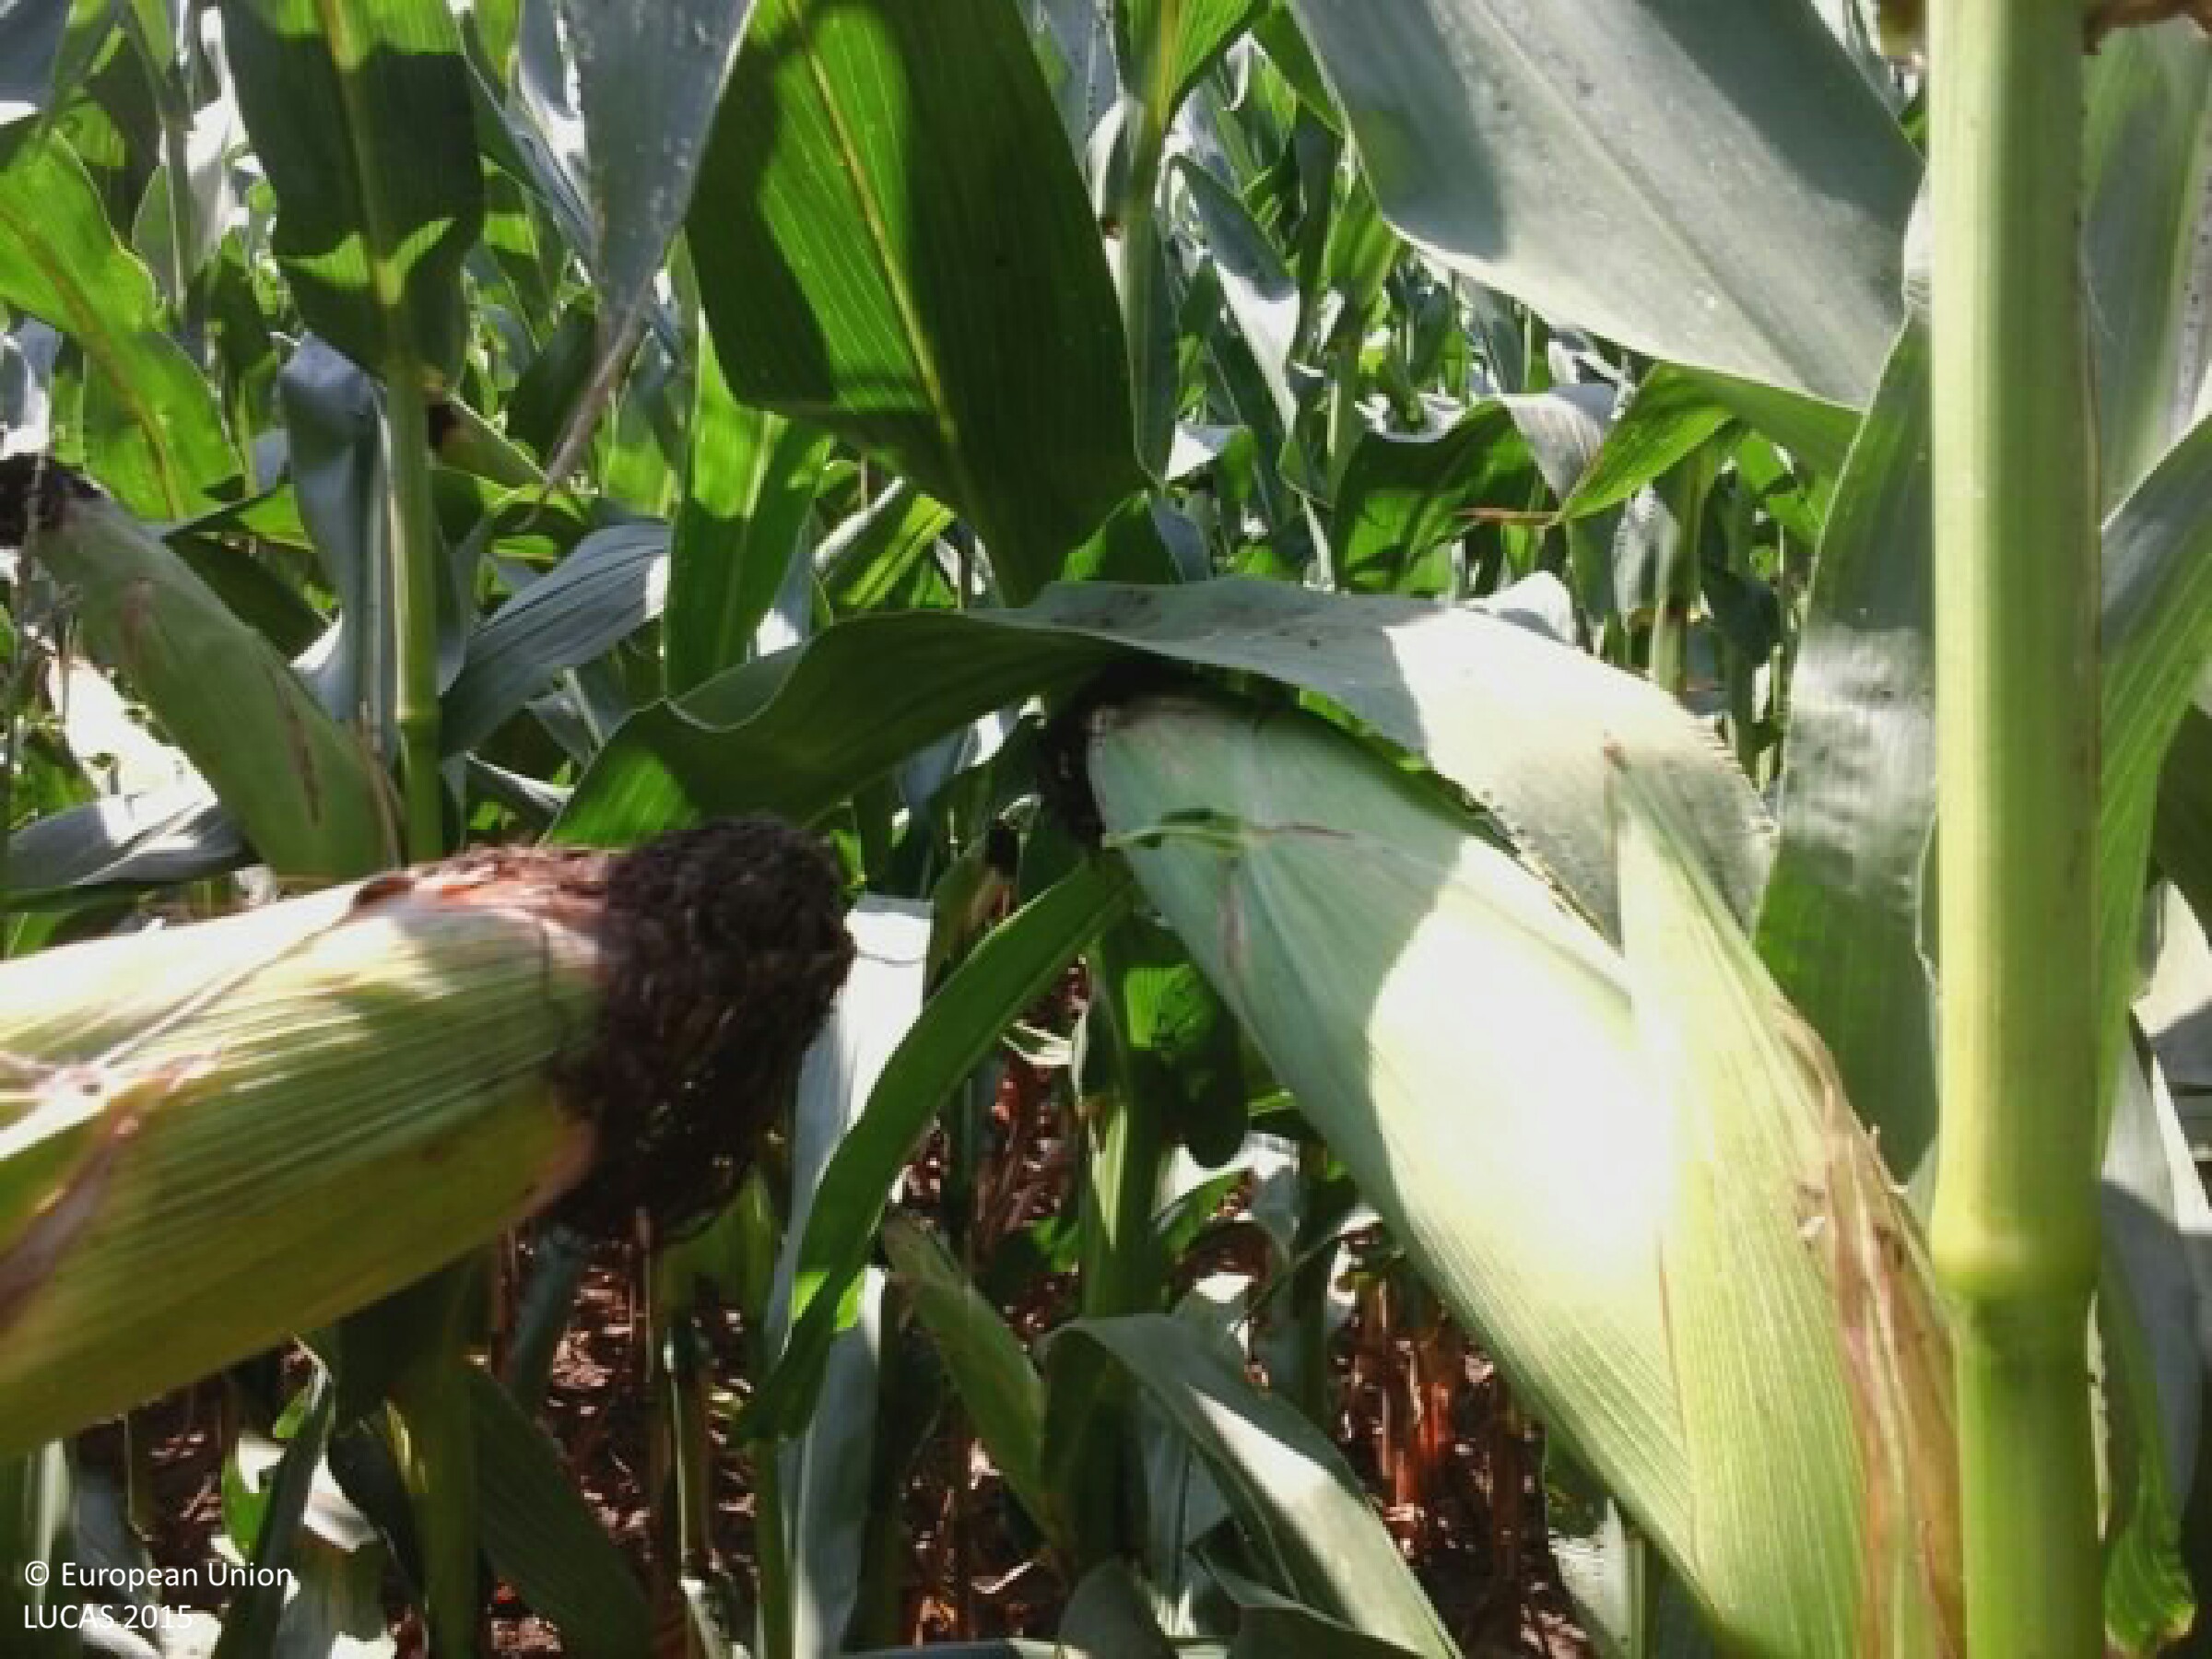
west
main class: Cropland
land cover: Maize
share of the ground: > 75 %
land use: Agriculture (excluding fallow land and kitchen gardens)
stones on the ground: < 10 %
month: August
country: HU
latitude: 46.4956
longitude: 17.8633
